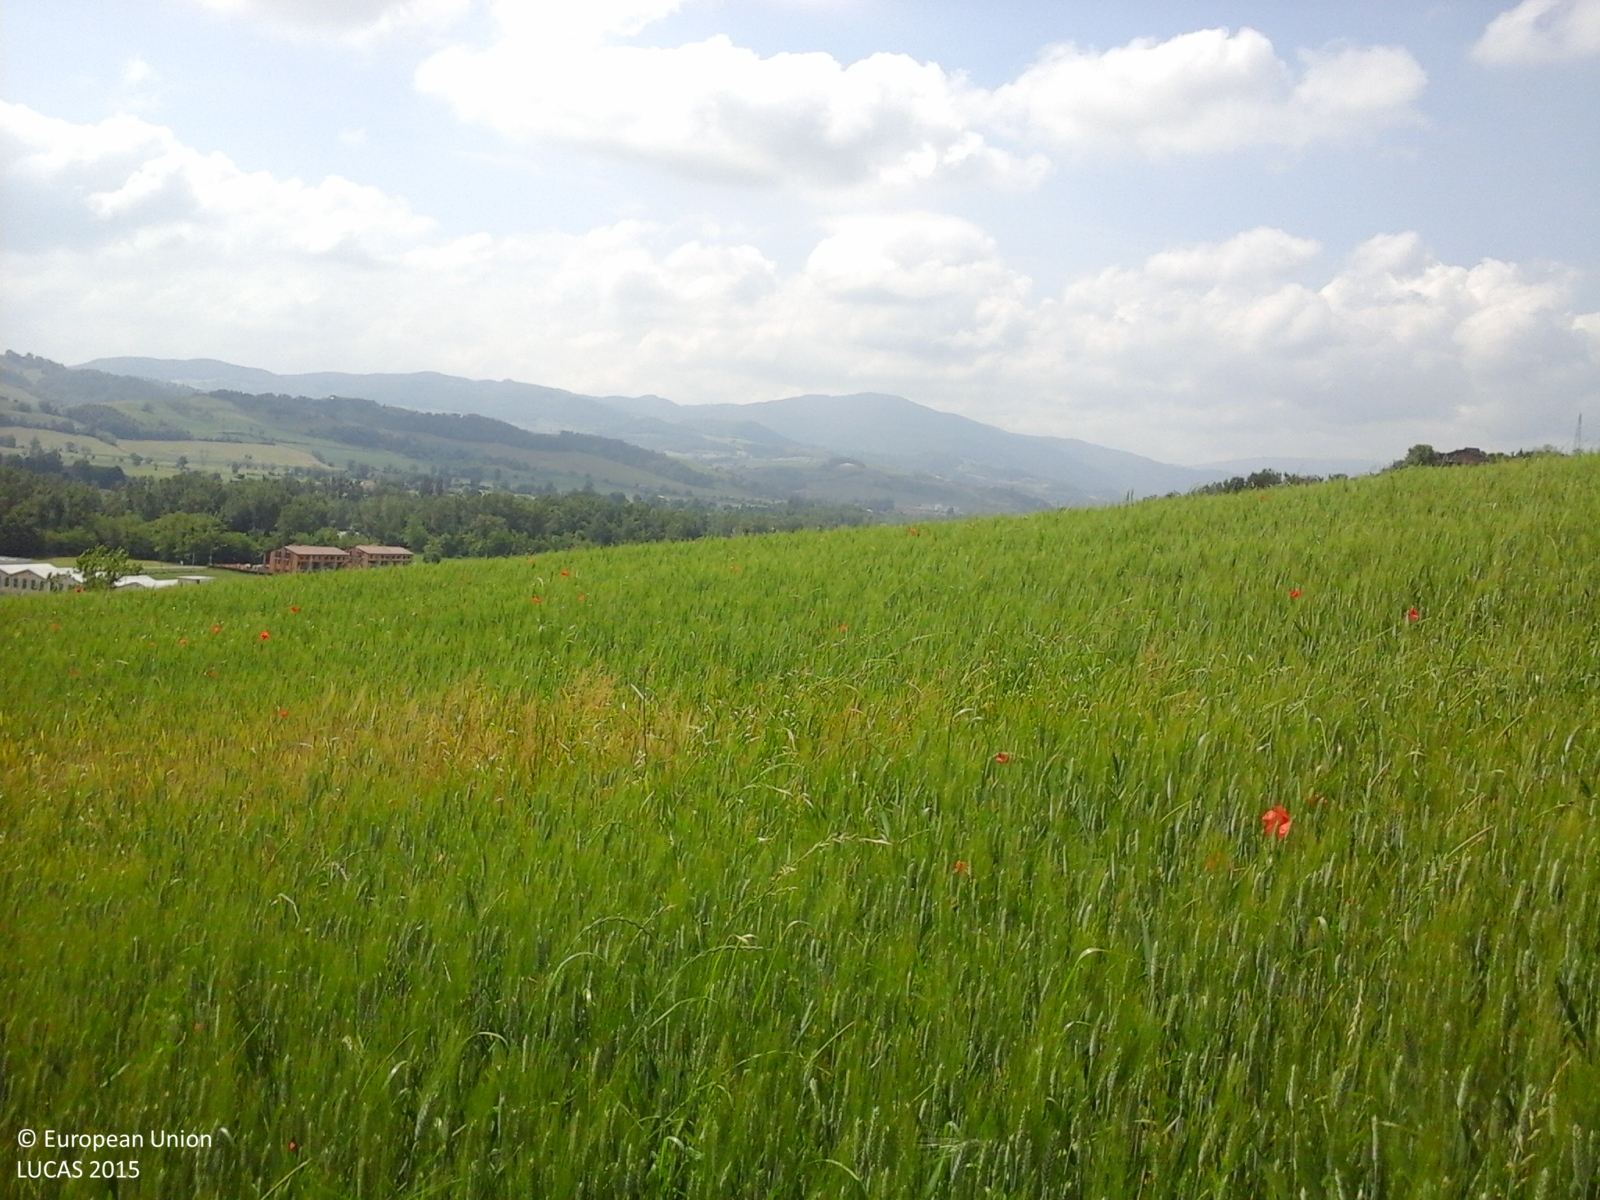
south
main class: Cropland
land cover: Common wheat
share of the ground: > 75 %
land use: Agriculture (excluding fallow land and kitchen gardens)
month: May
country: IT
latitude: 44.6930
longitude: 10.2141
